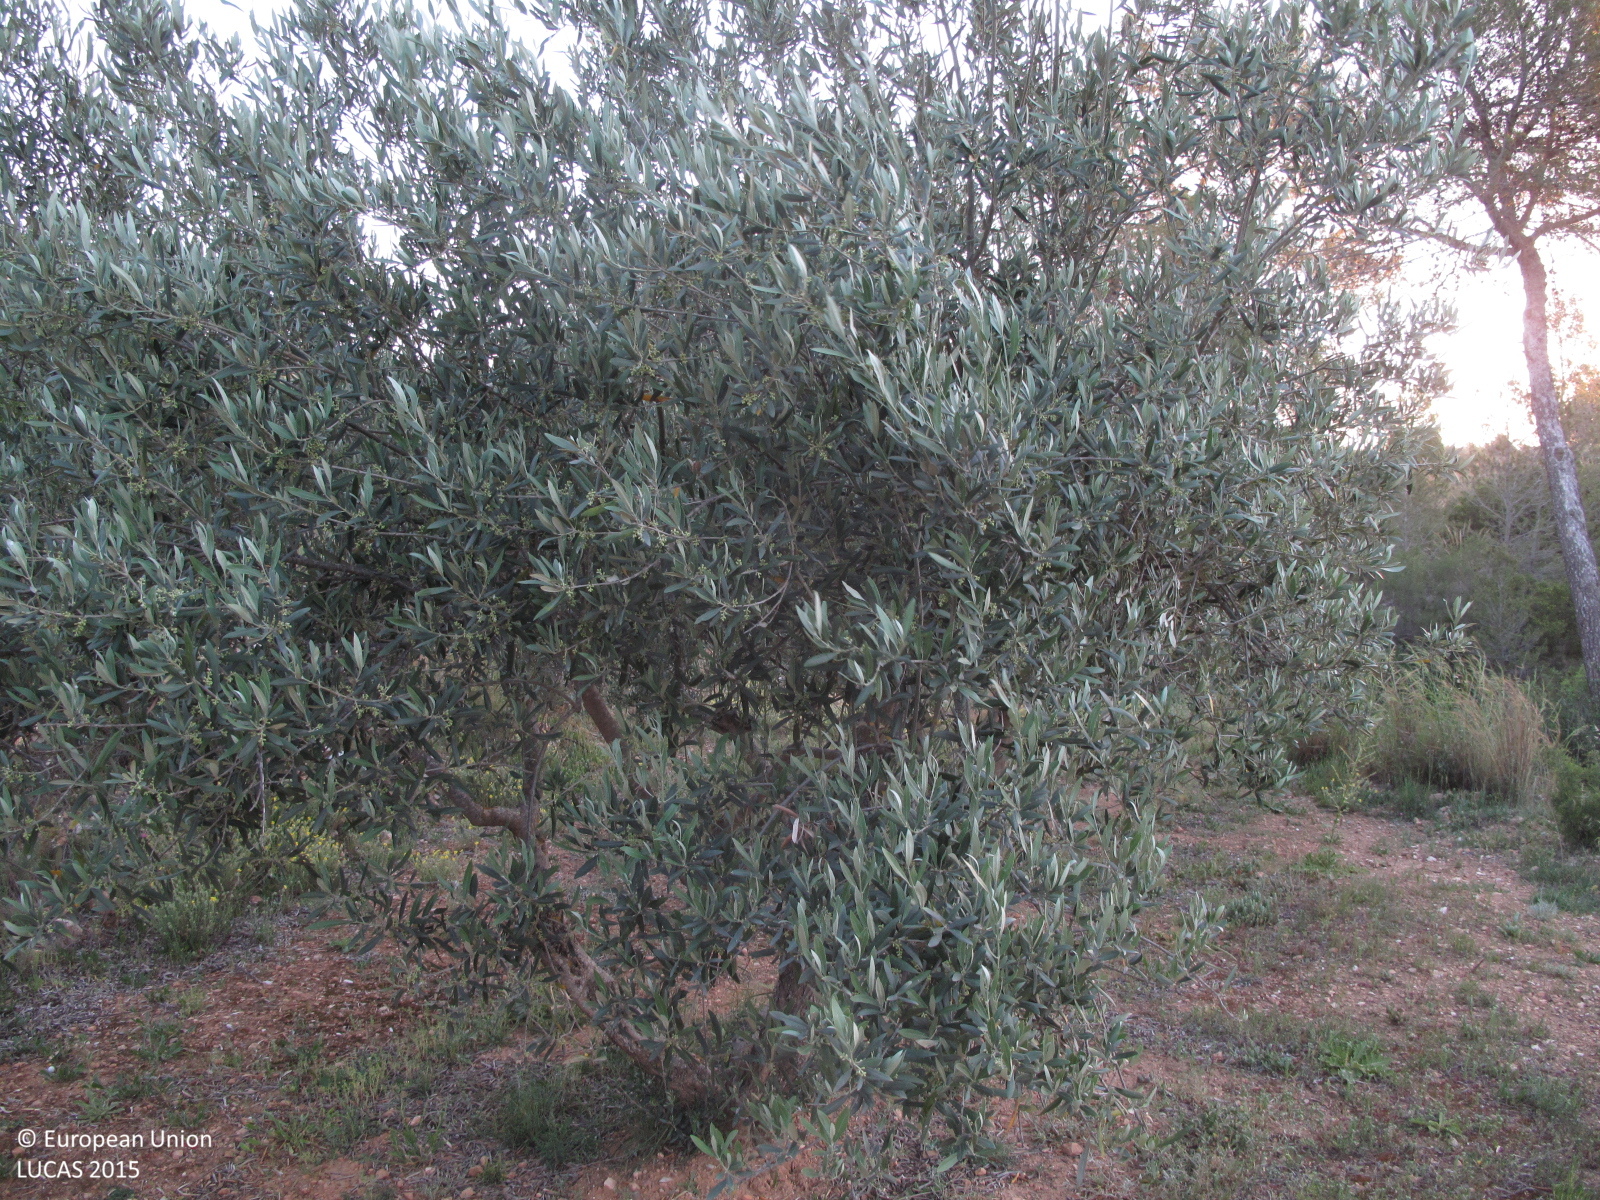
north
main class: Cropland
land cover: Olive groves
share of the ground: 25 - 50 %
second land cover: Spontaneously vegetated surfaces
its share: 25 - 50 %
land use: Agriculture (excluding fallow land and kitchen gardens)
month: May
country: ES
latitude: 38.8878
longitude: -0.7719
